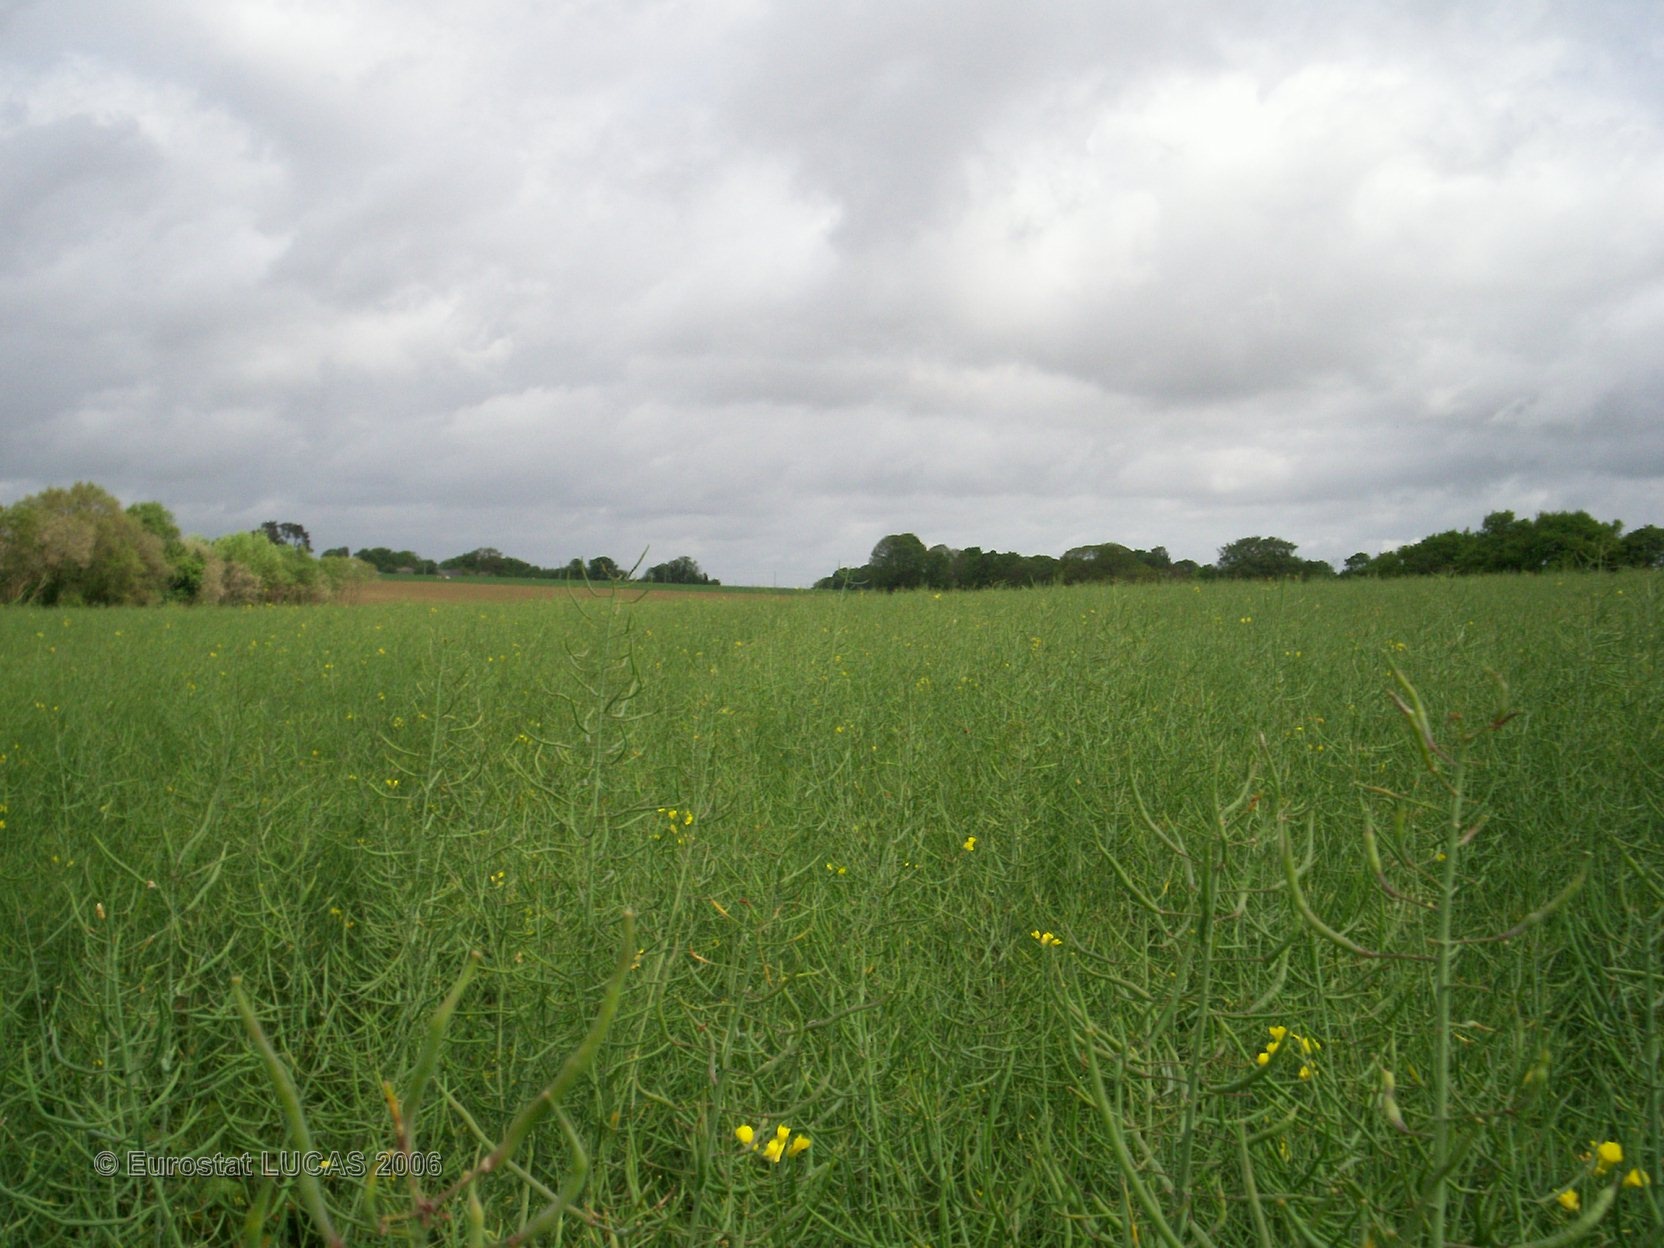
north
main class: Cropland
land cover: Rape and turnip rape
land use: Agriculture (excluding fallow land and kitchen gardens)
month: May
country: FR
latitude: 47.9445
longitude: -2.8235
